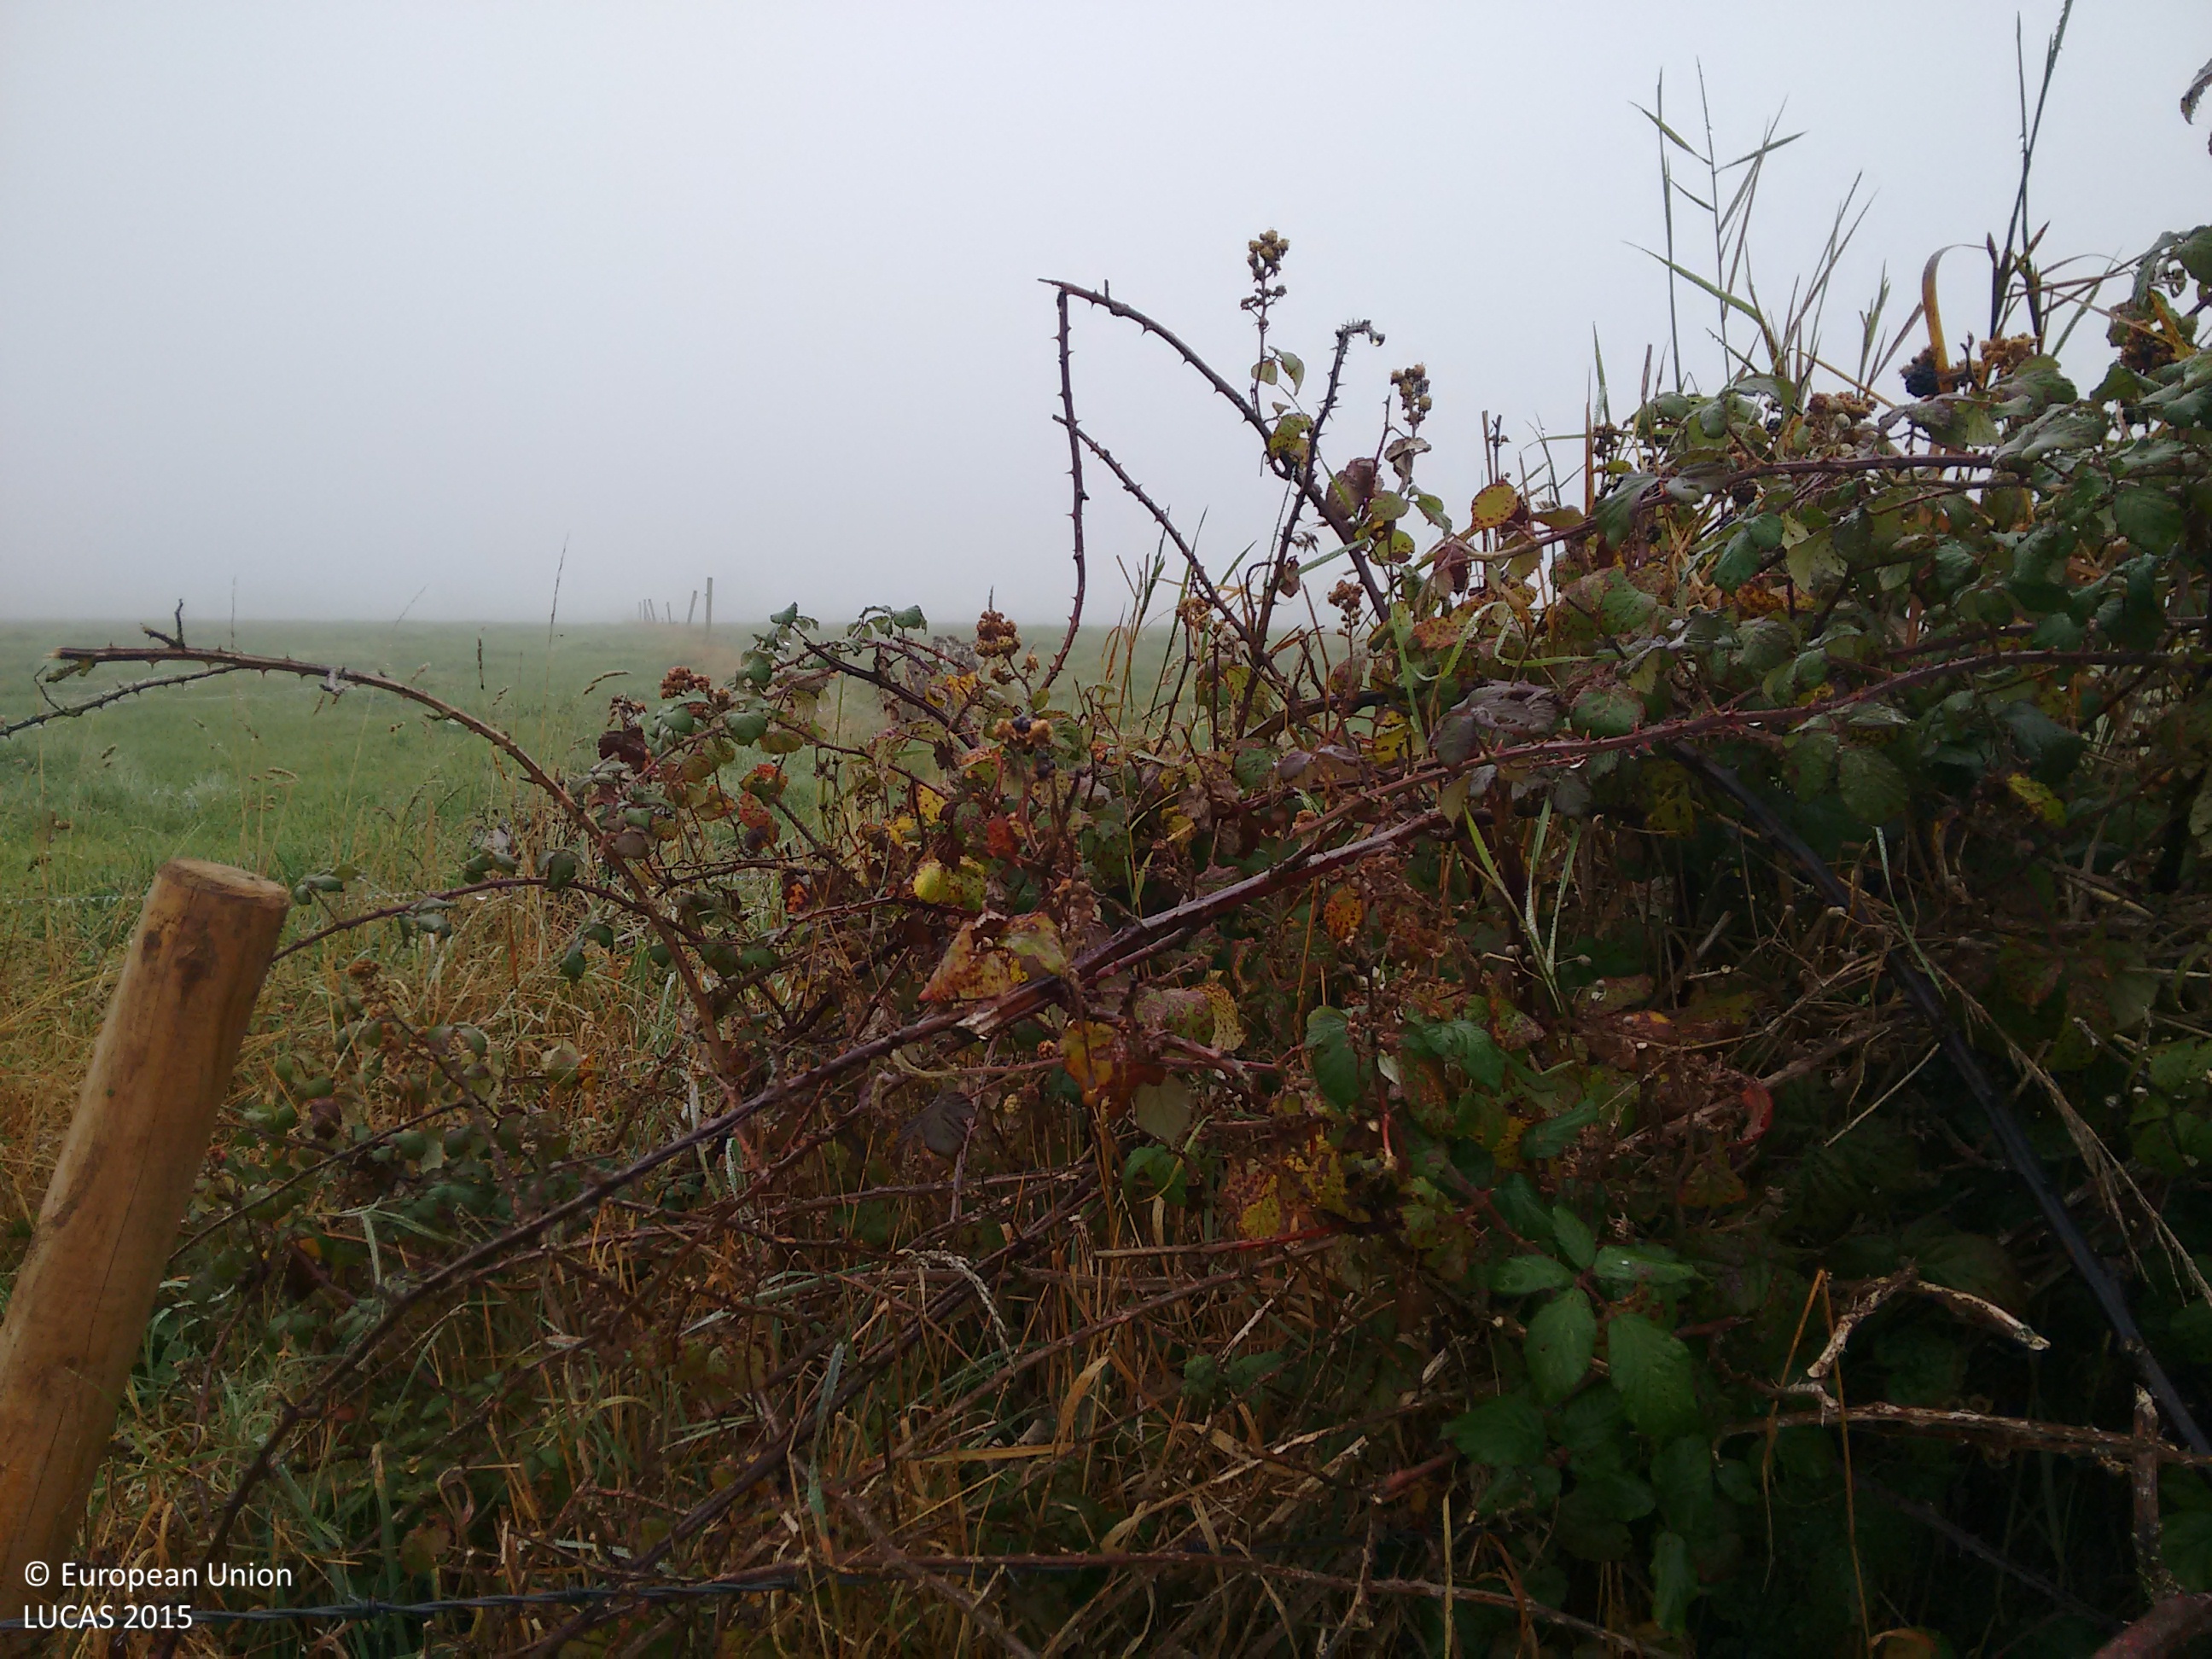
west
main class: Grassland
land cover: Grassland without tree/shrub cover
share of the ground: > 75 %
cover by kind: herbaceous plants 100 %
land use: Agriculture (excluding fallow land and kitchen gardens)
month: October
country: IE
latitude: 52.6390
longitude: -7.7985
